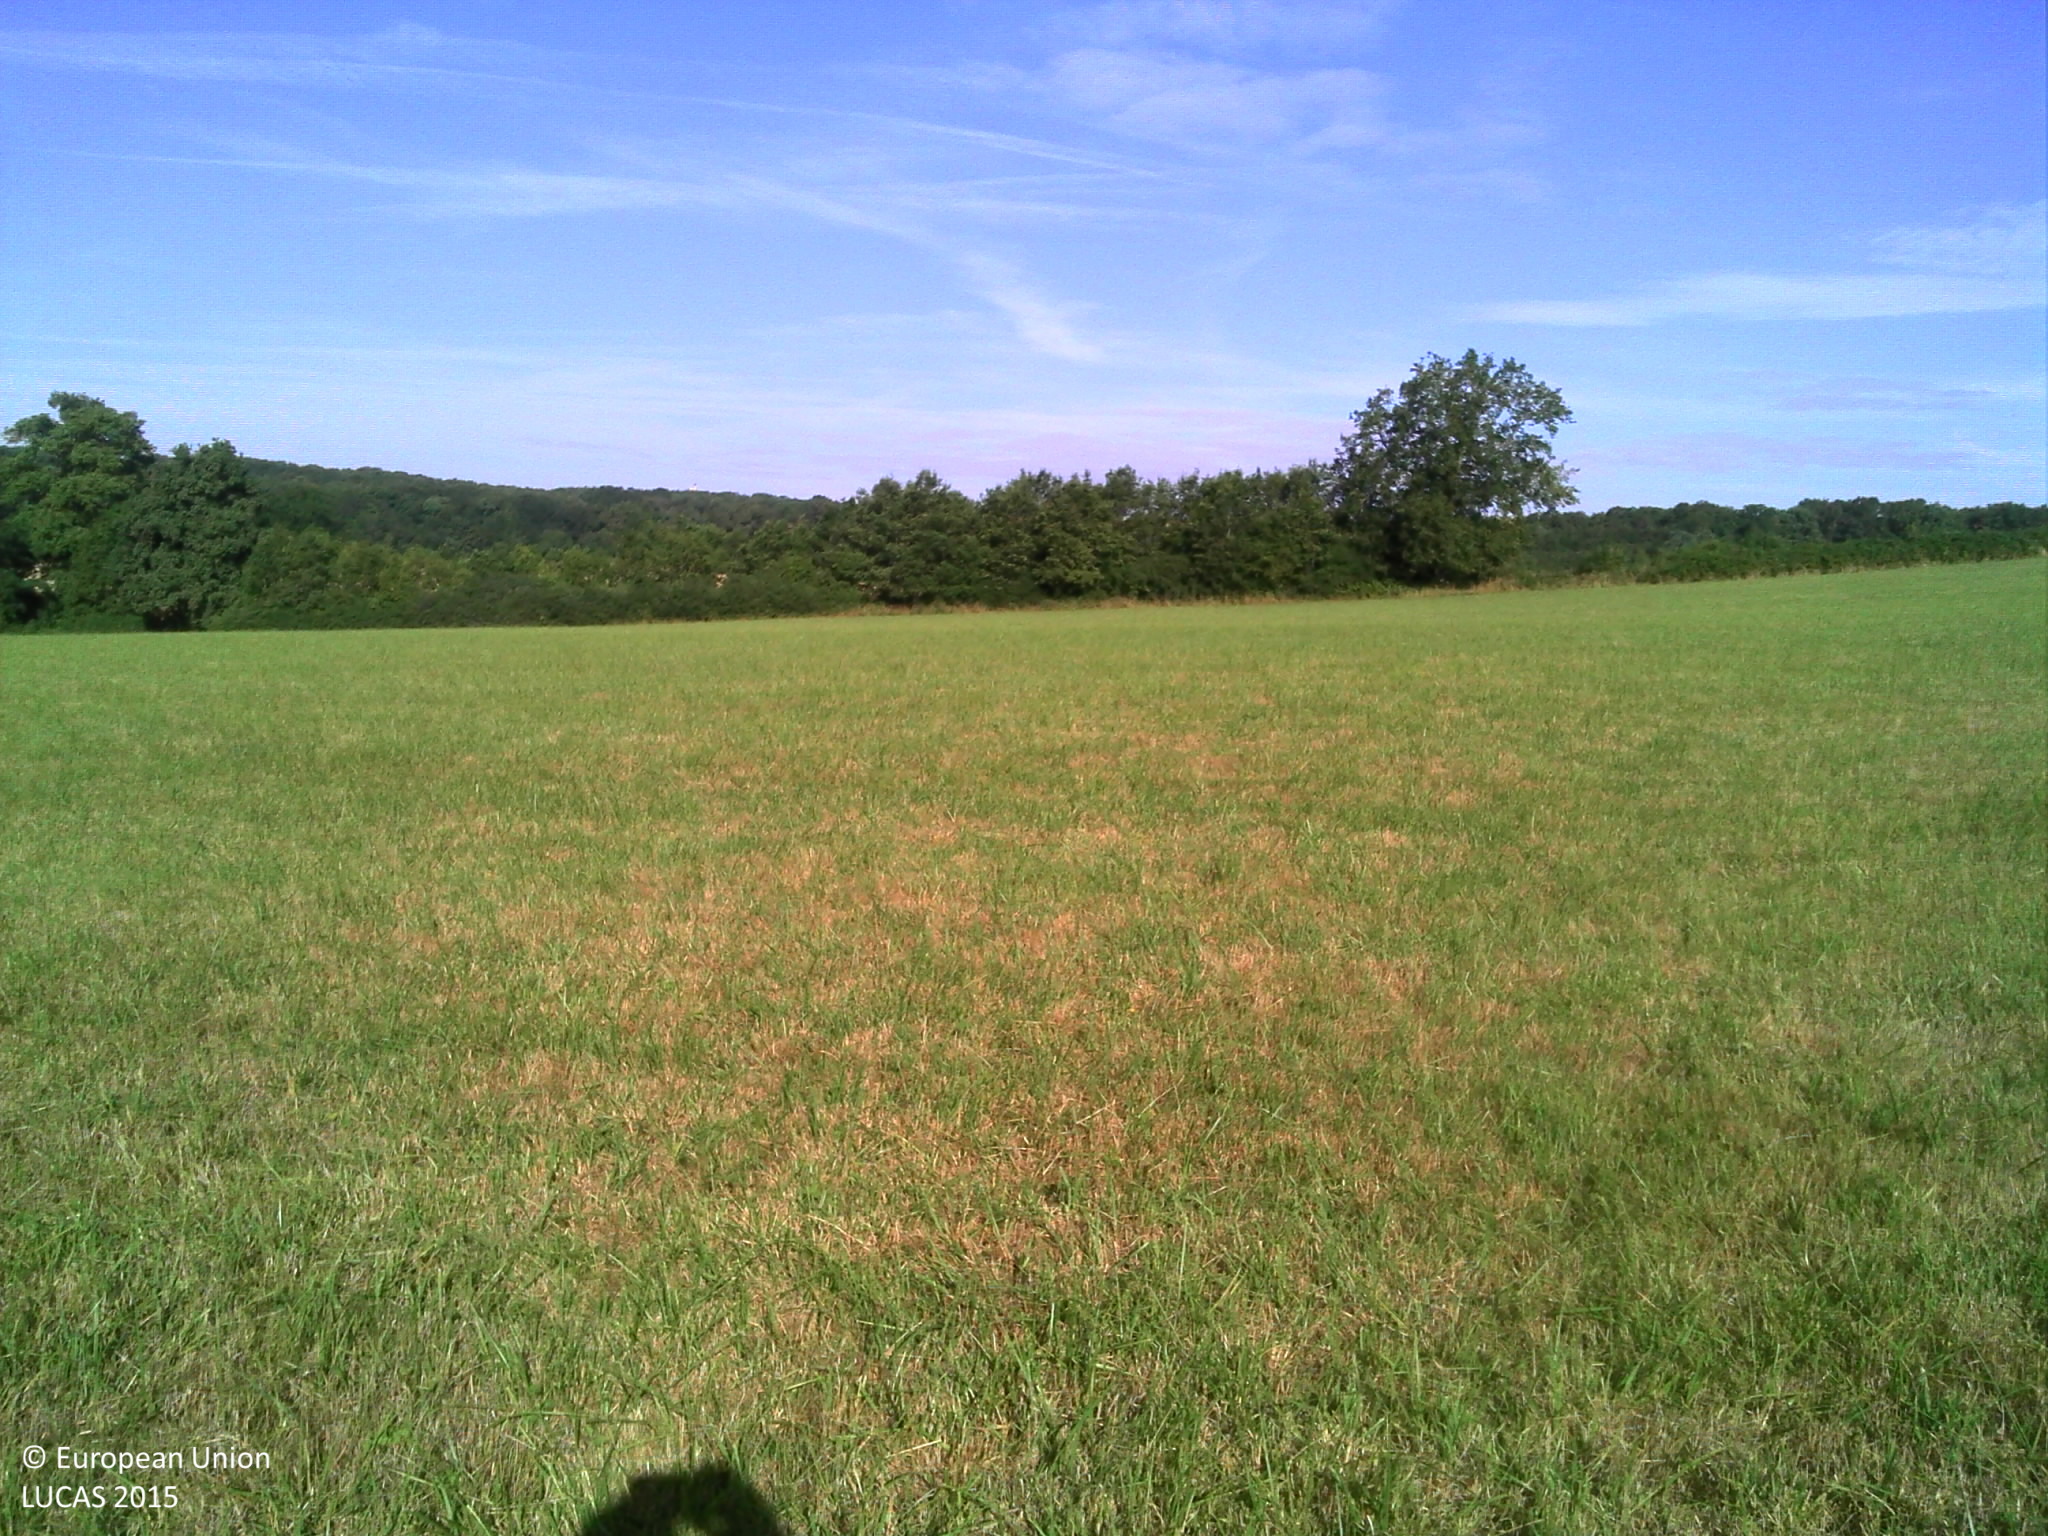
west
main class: Grassland
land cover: Grassland without tree/shrub cover
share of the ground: > 75 %
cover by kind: herbaceous plants 100 %
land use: Agriculture (excluding fallow land and kitchen gardens)
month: July
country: FR
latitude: 47.7576
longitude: 3.4452
